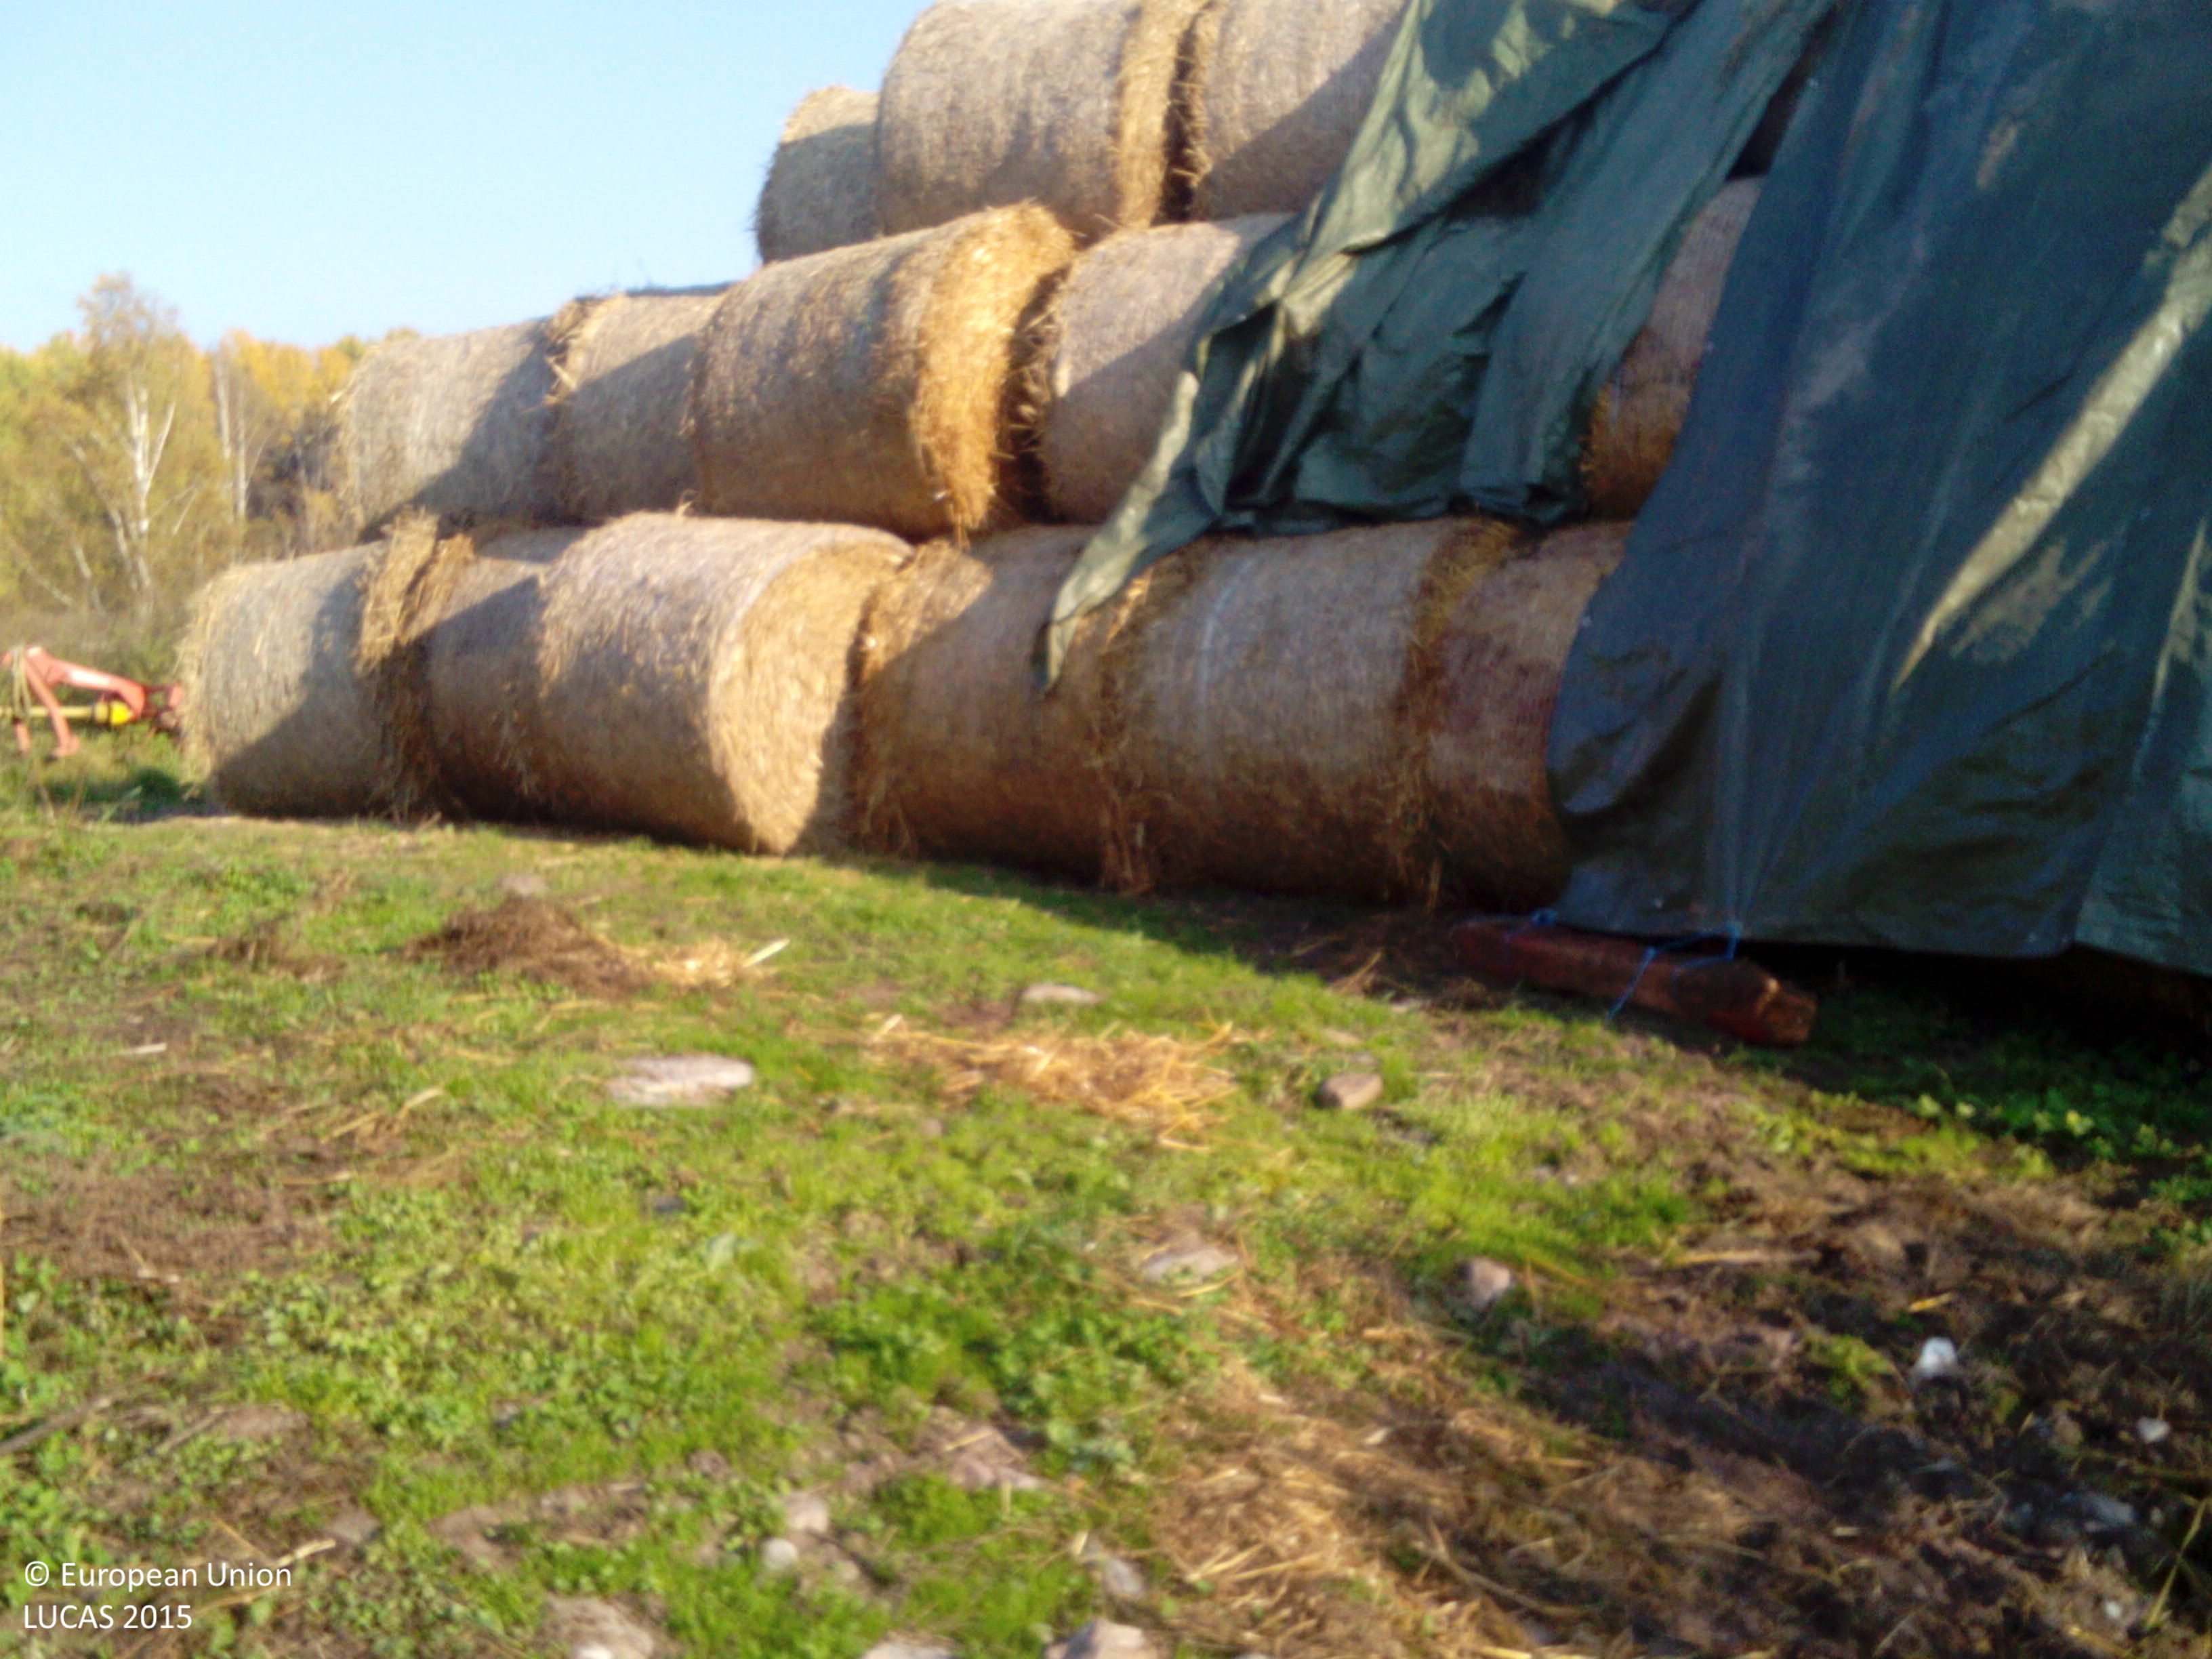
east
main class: Grassland
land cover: Spontaneously vegetated surfaces
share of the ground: 50 - 75 %
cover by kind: herbaceous plants 65 %, consolidated bare surface 10 %, unconsolidated bare surface 10 %
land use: Agriculture (excluding fallow land and kitchen gardens)
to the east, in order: Spontaneously vegetated surfaces; Artificial constructions; Grassland without tree/shrub cover; Fences; Grassland without tree/shrub cover; Other bare soil; Fences; Grassland without tree/shrub cover; Fences; Grassland without tree/shrub cover; Fences; Grassland without tree/shrub cover; Fences; Shruby margins; Ditches and canals; Spontaneously vegetated surfaces
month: October
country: SE
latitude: 58.8682
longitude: 16.2544
